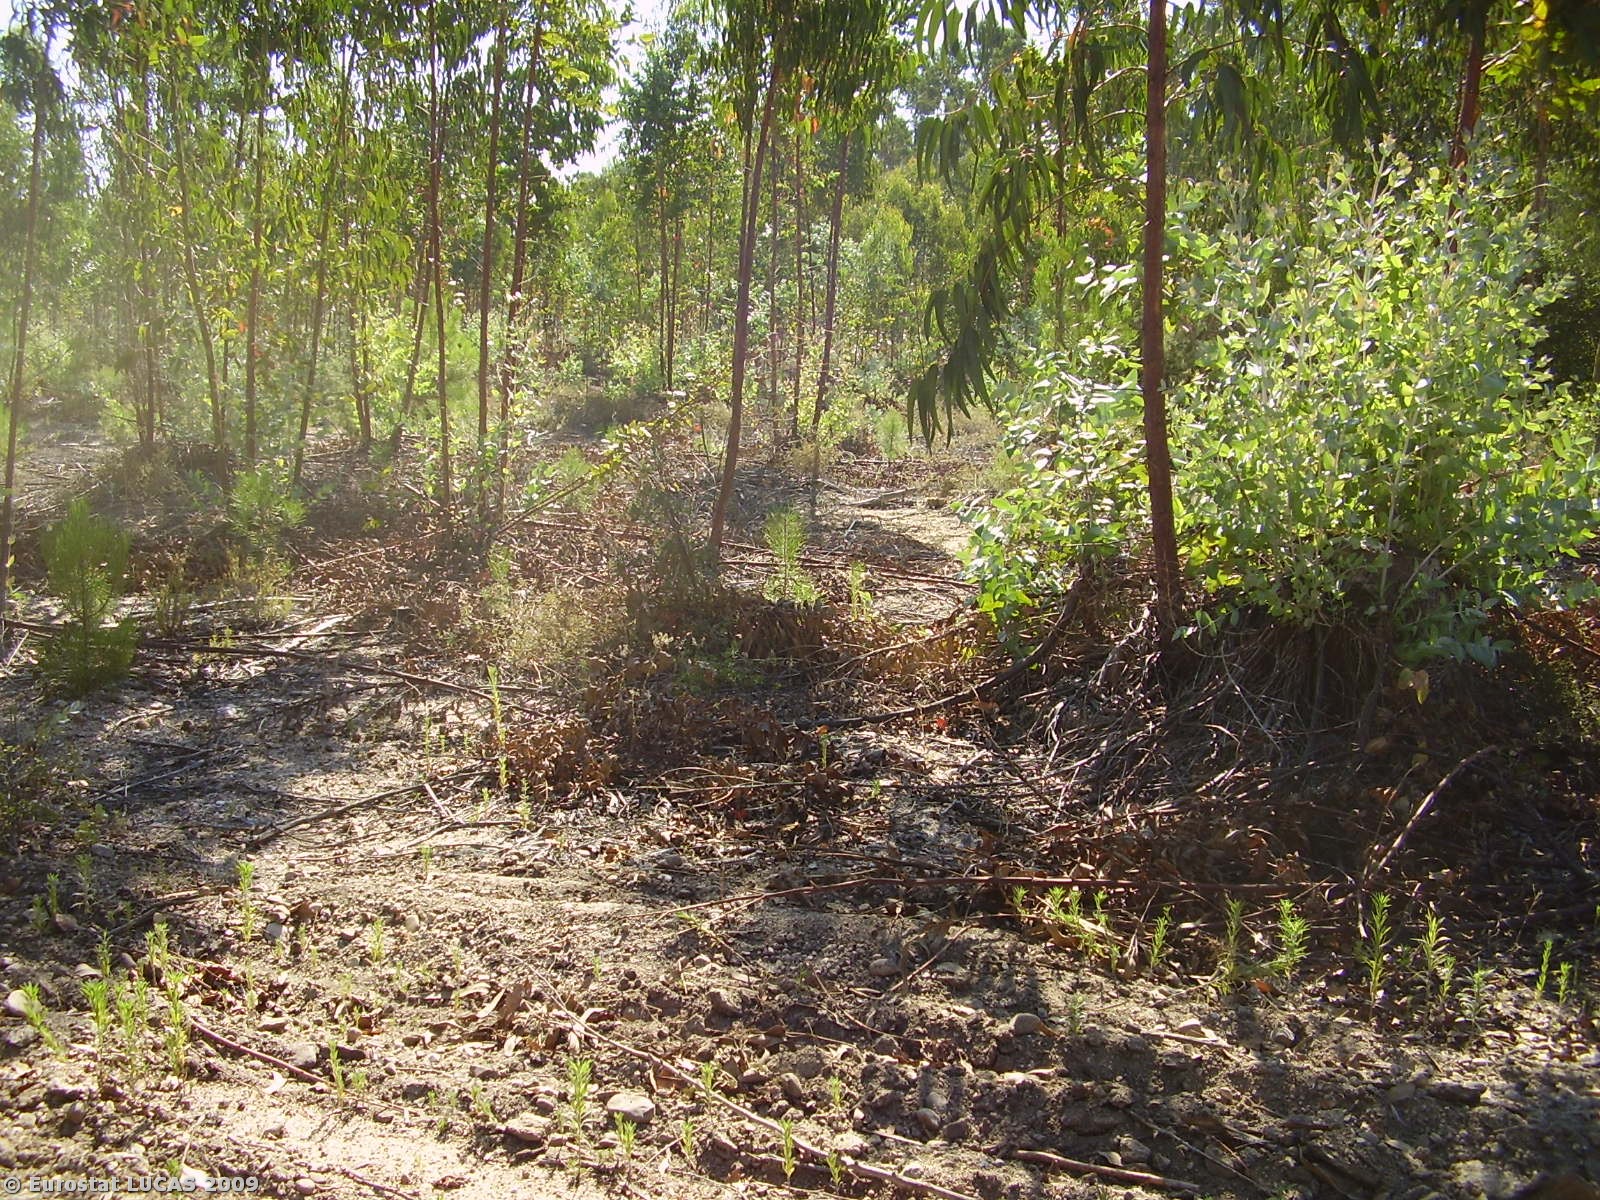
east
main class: Woodland
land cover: Broadleaved woodland
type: plantations and self-sown exotic forest
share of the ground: 25 - 50 %
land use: Forestry
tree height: > 5 m
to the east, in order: Broadleaved woodland
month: July
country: PT
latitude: 39.3404
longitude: -8.3152
